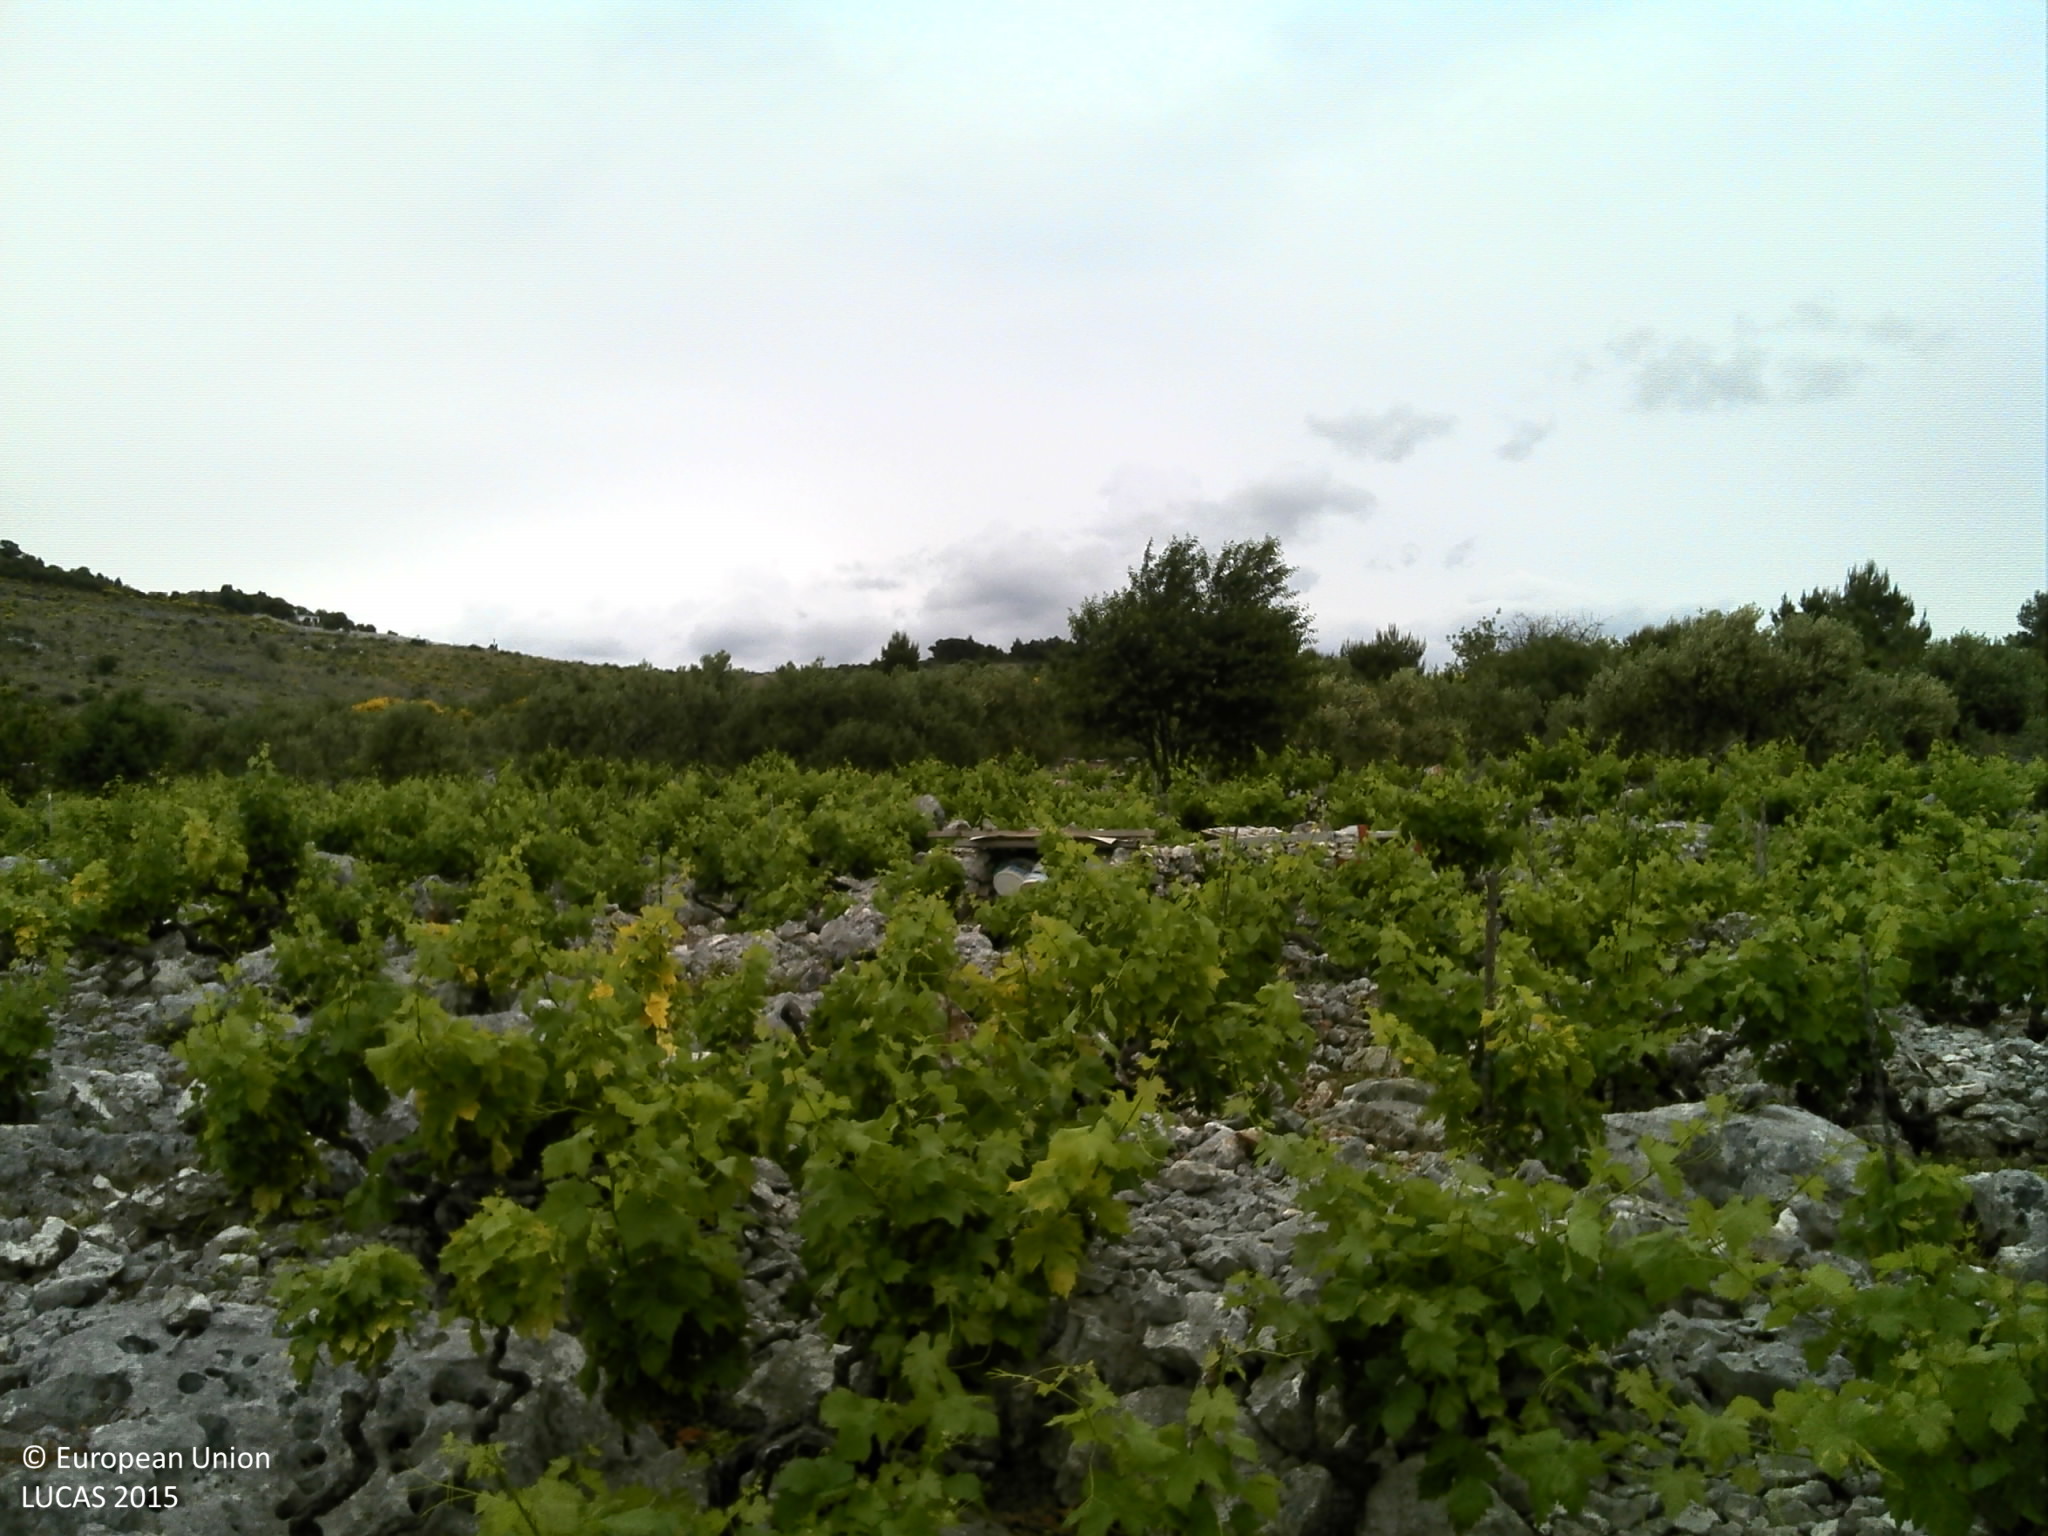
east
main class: Cropland
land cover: Vineyards
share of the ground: 25 - 50 %
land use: Agriculture (excluding fallow land and kitchen gardens)
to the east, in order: Vineyards; Rocks and stones; Dry stone walls; Vineyards; Dry stone walls; Vineyards; Dry stone walls; Vineyards; Dry stone walls; Vineyards; Dry stone walls; Vineyards; Dry stone walls; Vineyards; Dry stone walls; Vineyards; Dry stone walls; Vineyards; Dry stone walls; Vineyards; Dry stone walls; Tracks; Dry stone walls; Vineyards; Dry stone walls; Vineyards; Dry stone walls; Vineyards; Dry stone walls; Vineyards; Dry stone walls; Vineyards; Dry stone walls; Olive groves; Dry stone walls; Olive groves; Dry stone walls; Olive groves; Dry stone walls; Olive groves; Dry stone walls; Olive groves; Dry stone walls; Vineyards; Dry stone walls; Vineyards; Dry stone walls; Vineyards; Dry stone walls; Vineyards; Dry stone walls; Vineyards; Dry stone walls; Vineyards; Dry stone walls; Broadleaved woodland; Shrubland without tree cover
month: May
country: HR
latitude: 43.5652
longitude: 15.9456
